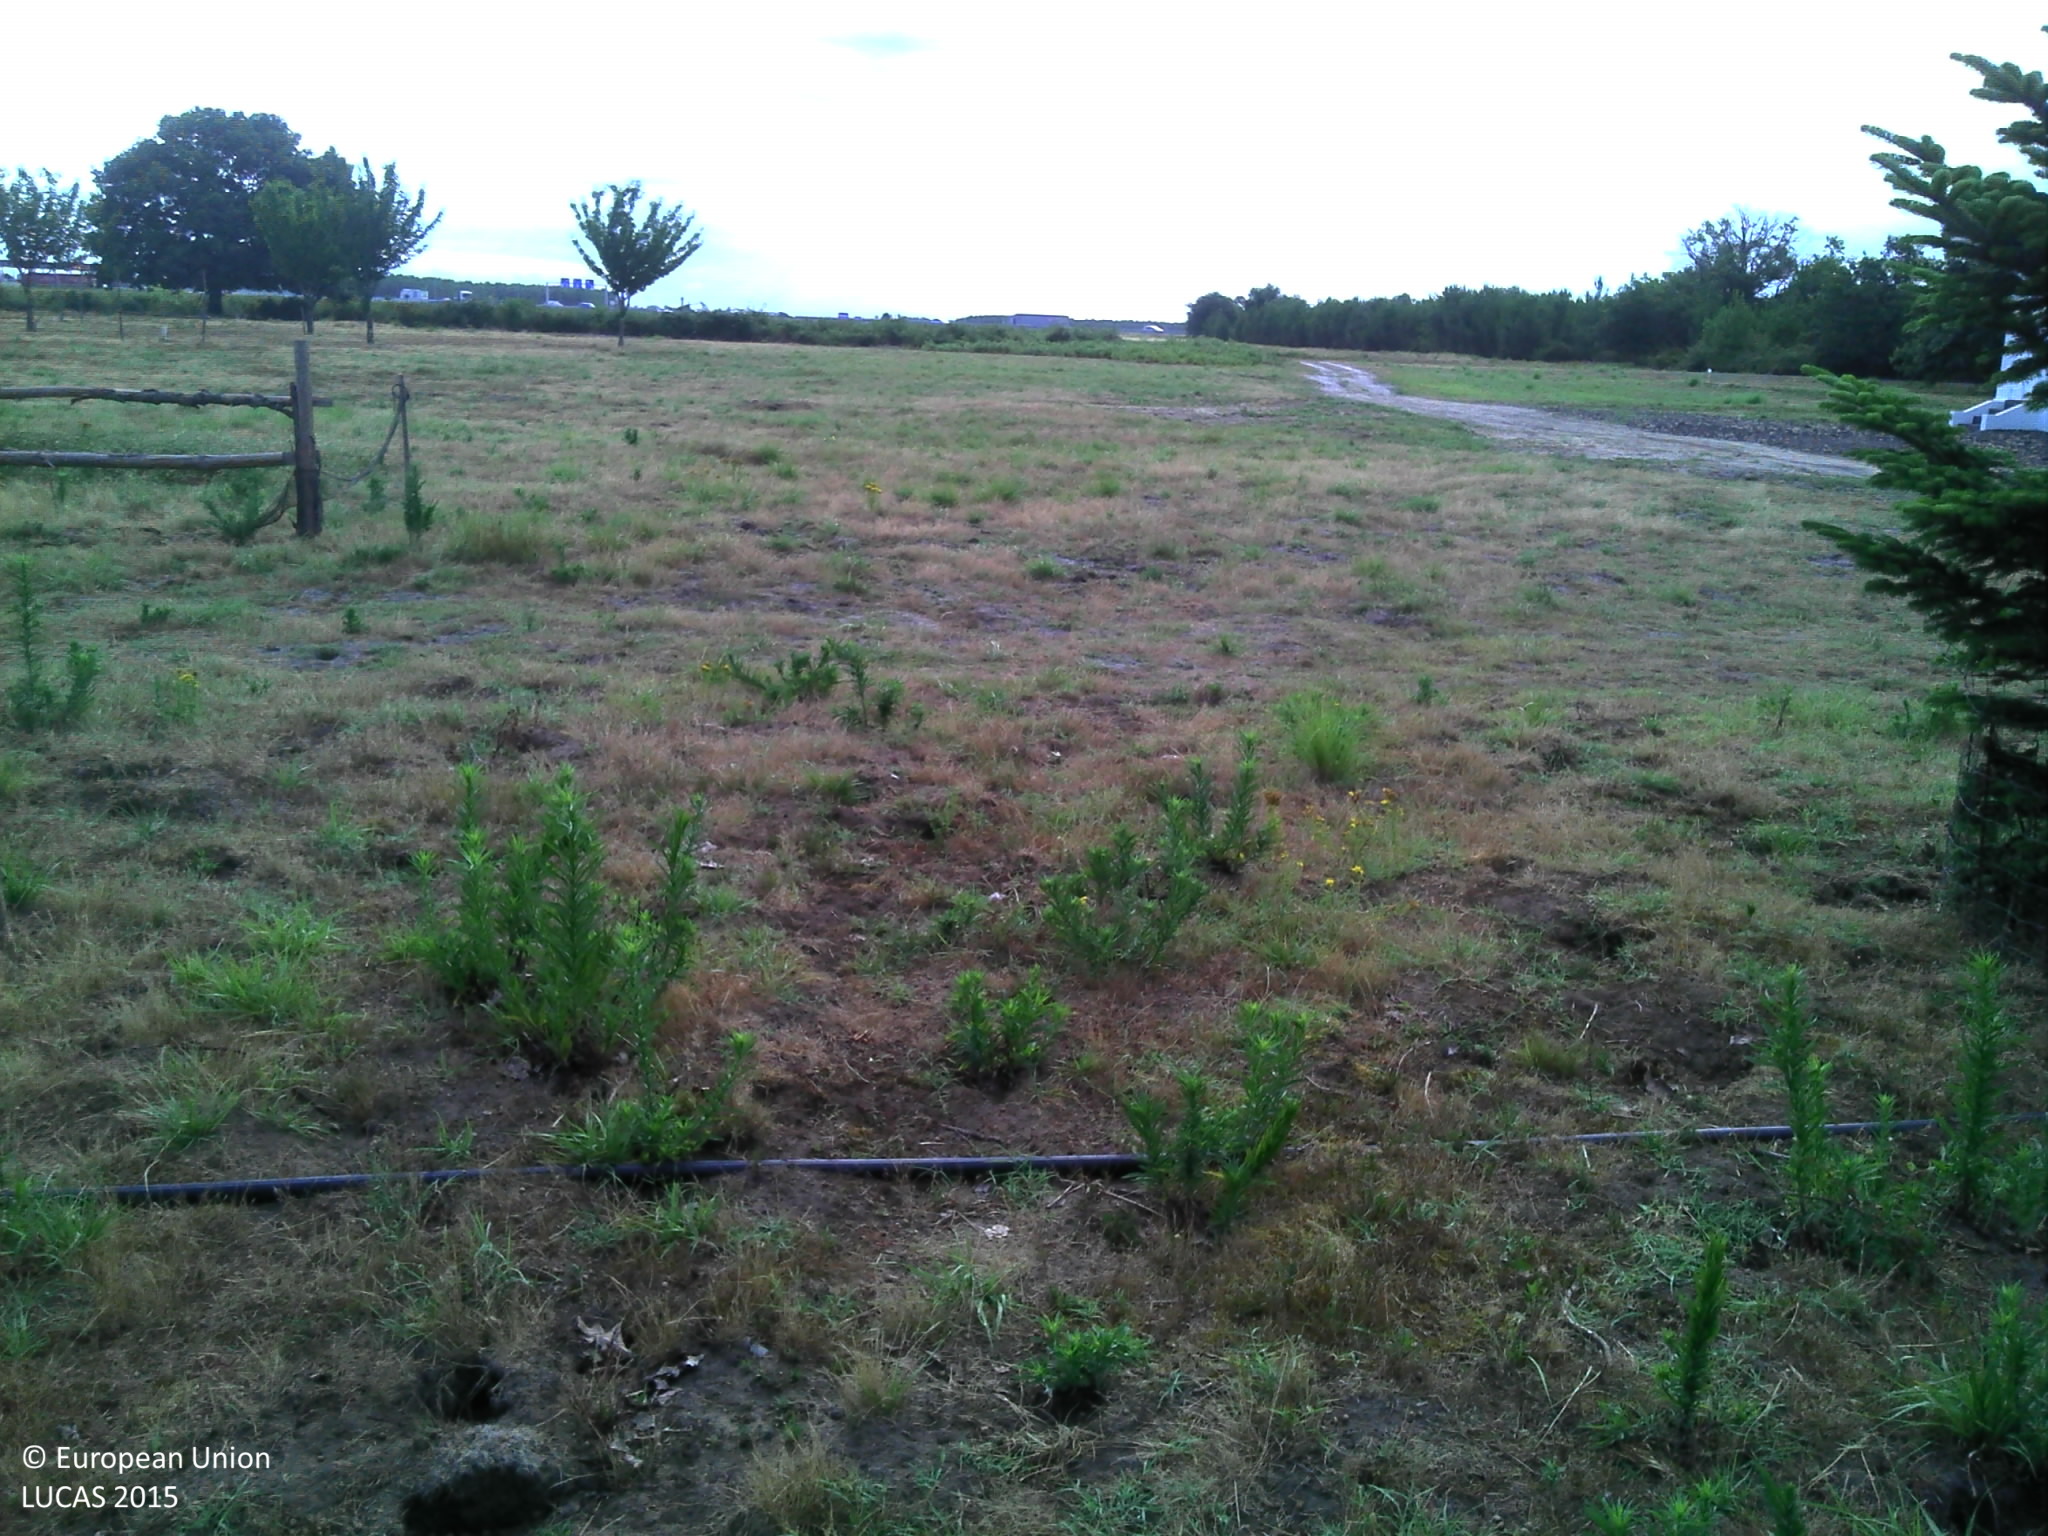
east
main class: Grassland
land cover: Grassland with sparse tree/shrub cover
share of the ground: > 75 %
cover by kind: herbaceous plants 95 %, coniferous forest trees 5 %
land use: Residential
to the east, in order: Grassland with sparse tree/shrub cover; Tracks; Grassland with sparse tree/shrub cover; Tracks; Grassland without tree/shrub cover; Tracks; Grassland without tree/shrub cover; Pine dominated coniferous woodland
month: July
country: FR
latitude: 44.3418
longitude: -0.8680
